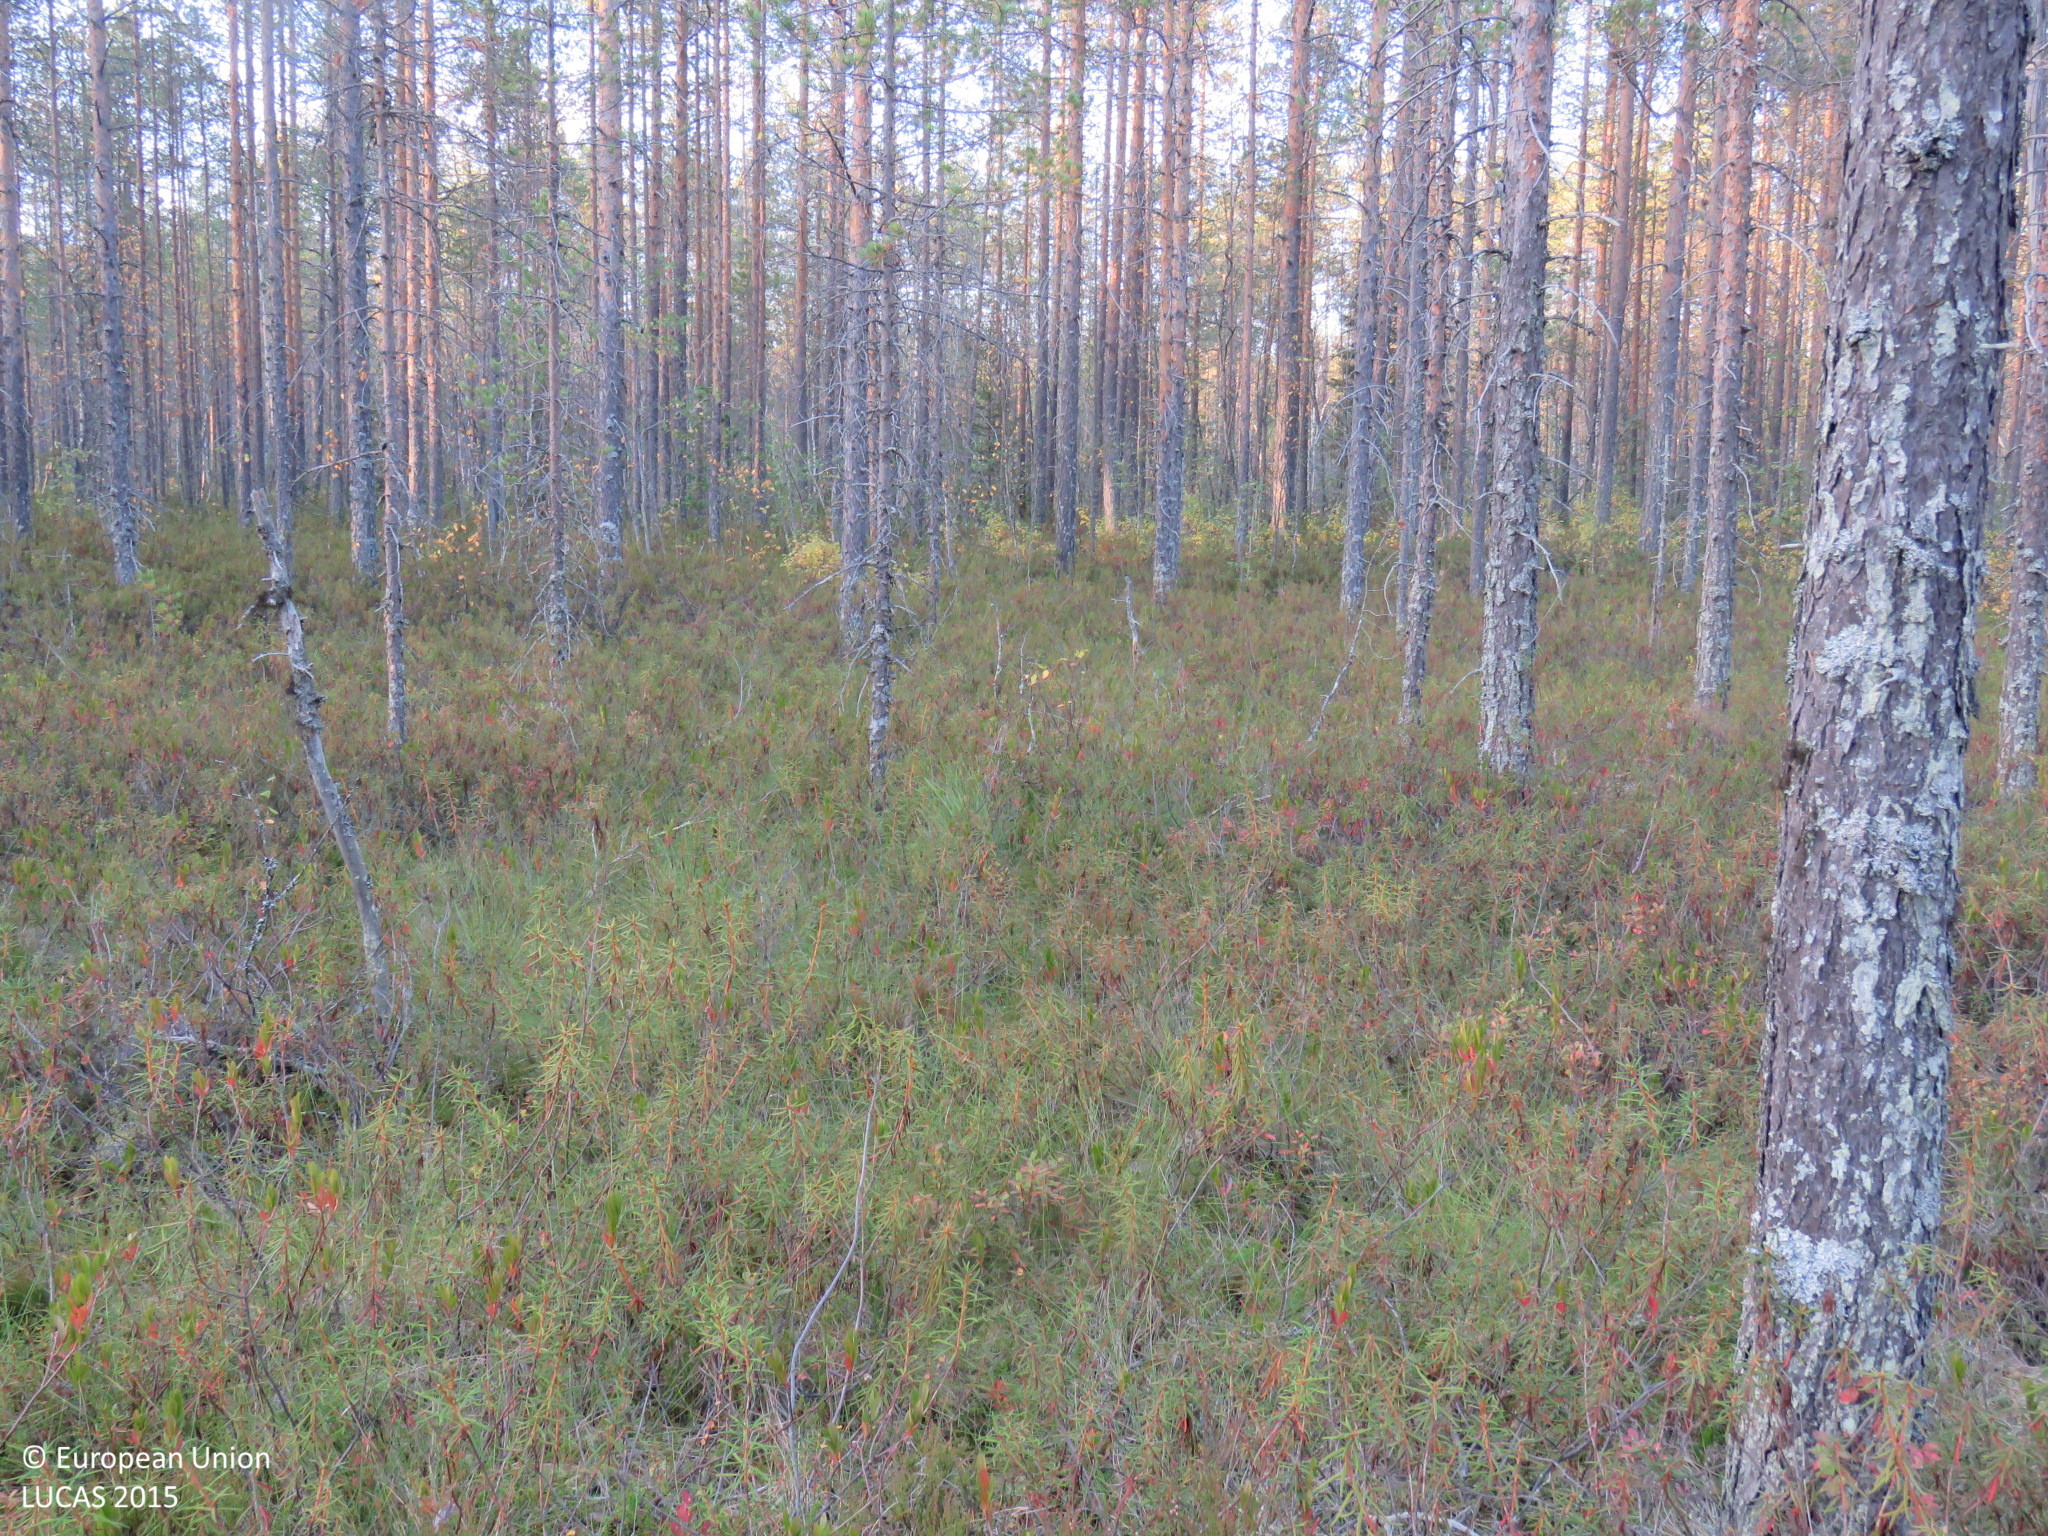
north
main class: Woodland
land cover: Pine dominated coniferous woodland
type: mire and swamp forests
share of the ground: > 75 %
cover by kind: coniferous forest trees 70 %, shrubs 15 %, broadleaved forest trees 5 %, herbaceous plants 5 %, lichens and mosses 5 %
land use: Forestry
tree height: > 5 m
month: September
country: FI
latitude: 65.0354
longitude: 26.7845
